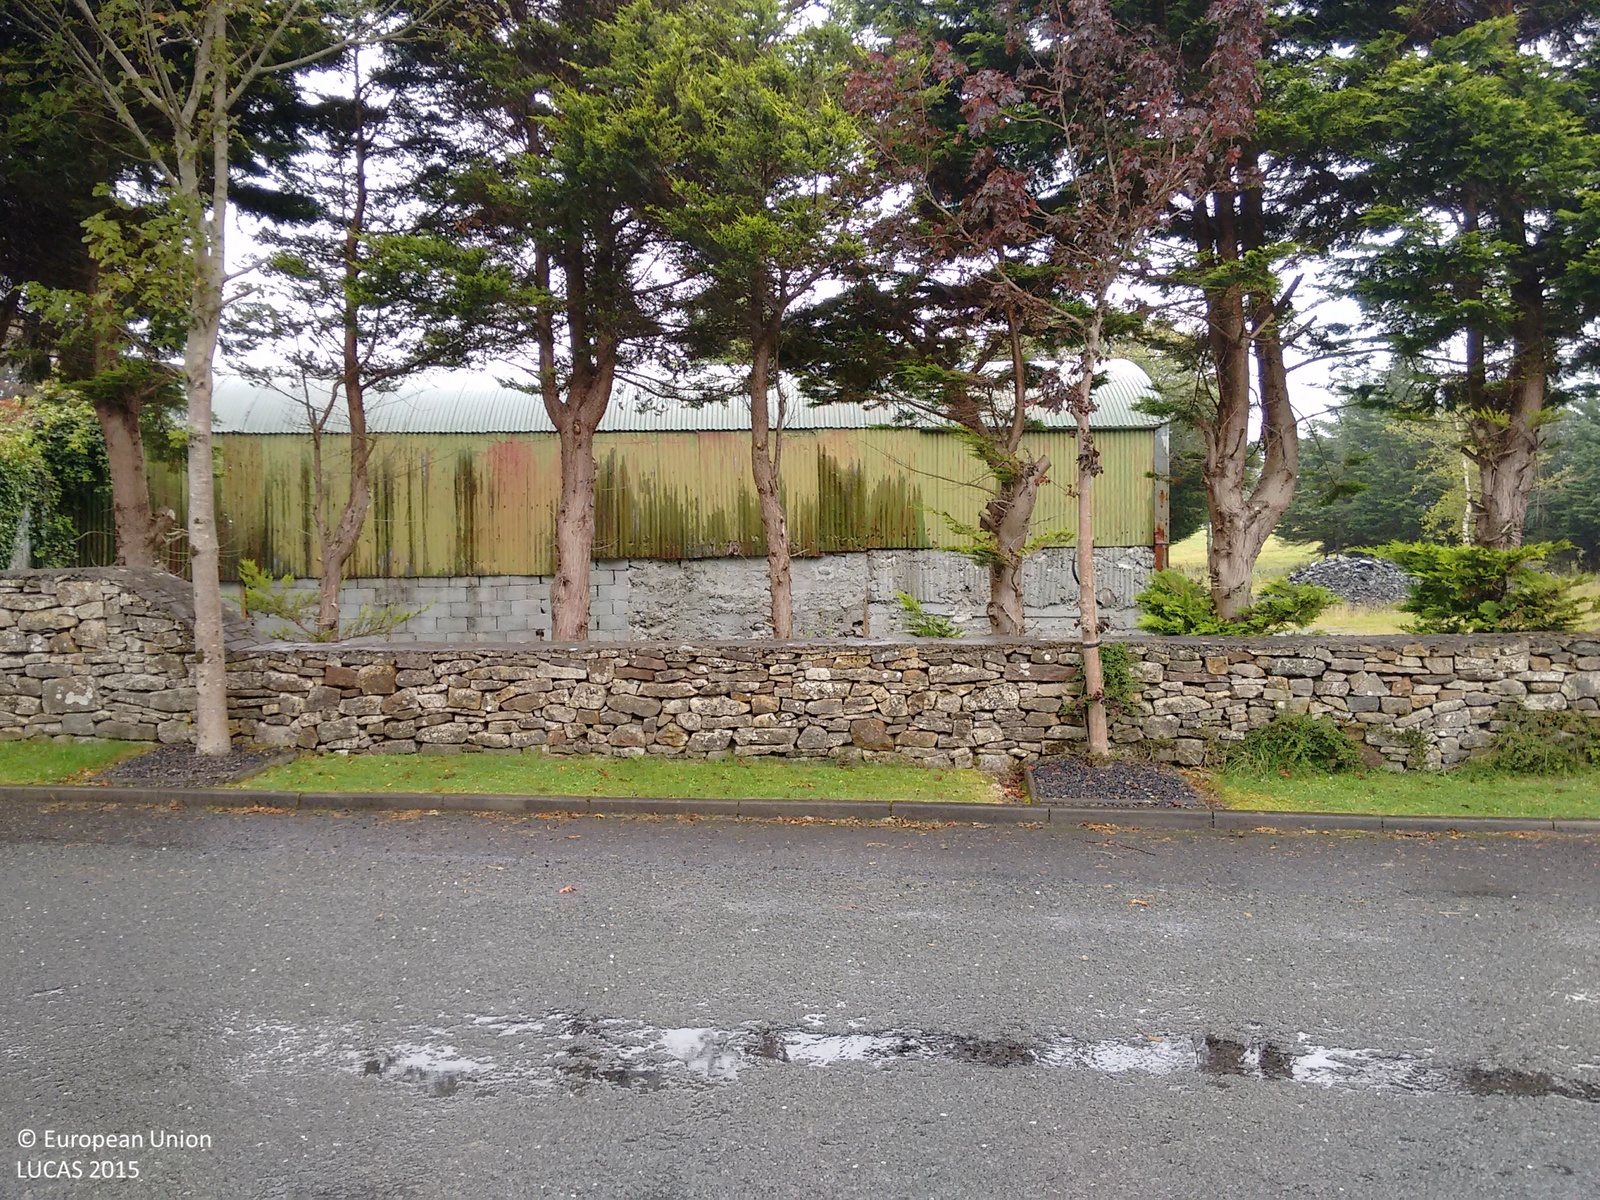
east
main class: Woodland
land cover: Spruce dominated coniferous woodland
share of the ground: > 75 %
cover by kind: coniferous forest trees 70 %, herbaceous plants 25 %, shrubs 5 %
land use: Residential
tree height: > 5 m
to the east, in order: Spruce dominated coniferous woodland; Pine dominated coniferous woodland; Artificial constructions in urban areas; Grassland without tree/shrub cover; Broadleaved woodland; Ditches and canals; Fences; Grassland without tree/shrub cover; Dry stone walls; Paved roads, cycling and walking lanes; Dry stone walls; Fences; Electric lines; Dry stone walls; Fences
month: September
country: IE
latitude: 54.0284
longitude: -9.3222
